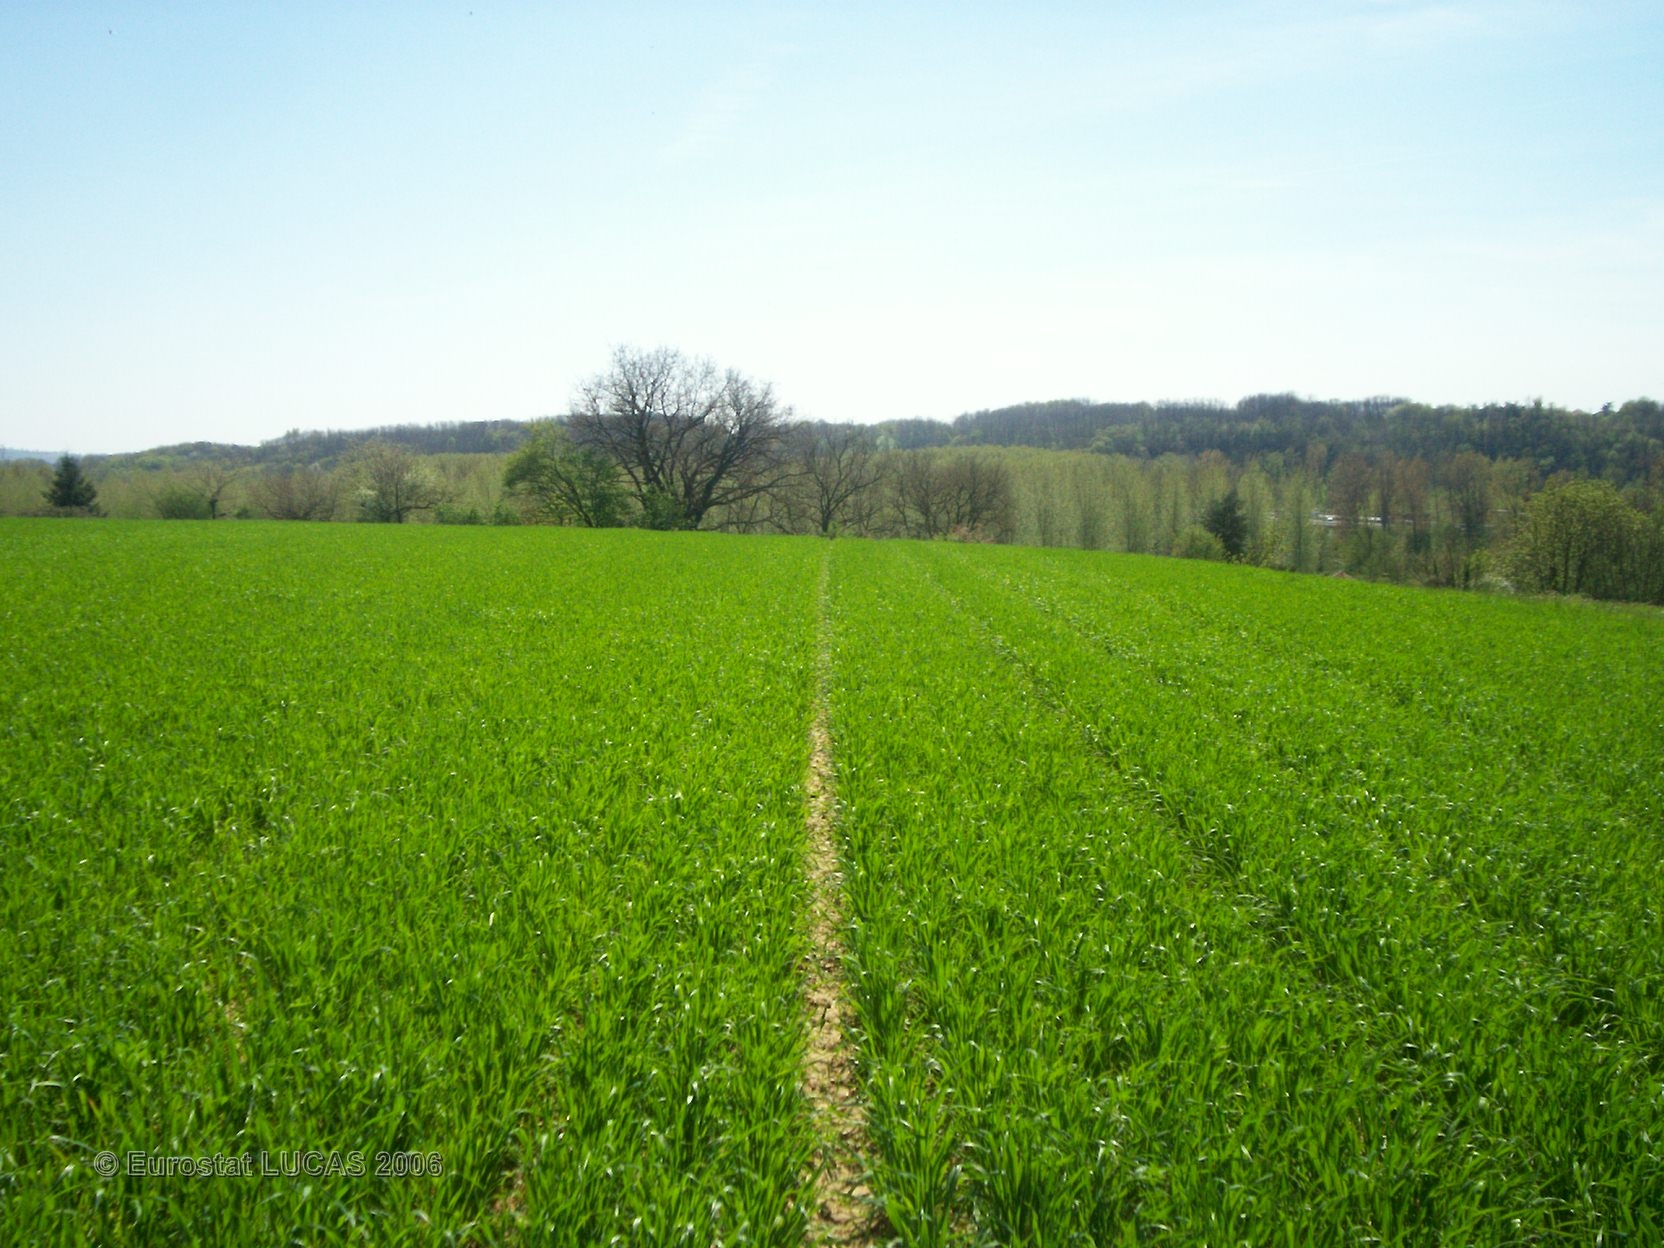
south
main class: Cropland
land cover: Common wheat
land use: Agriculture (excluding fallow land and kitchen gardens)
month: April
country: FR
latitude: 45.4318
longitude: 4.8276
